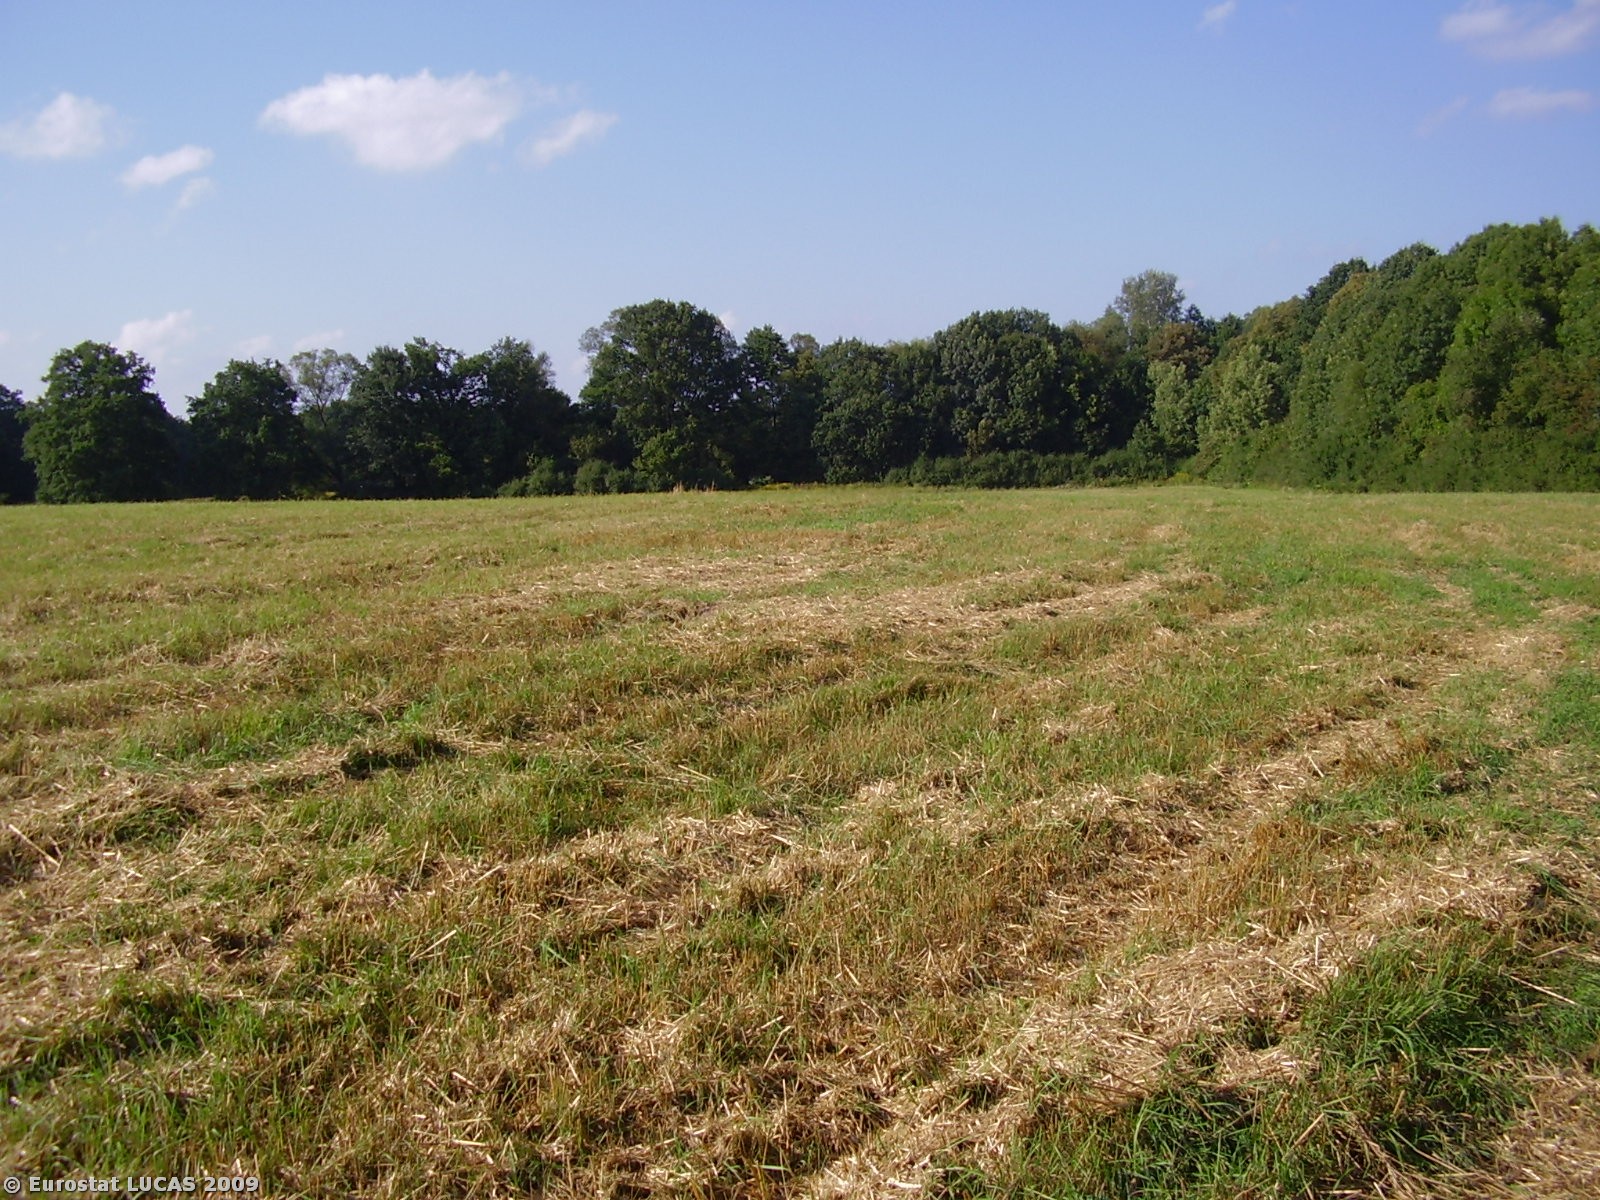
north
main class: Cropland
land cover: Rye
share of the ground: < 10 %
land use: Agriculture (excluding fallow land and kitchen gardens)
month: August
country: PL
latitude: 51.2512
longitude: 16.9875
